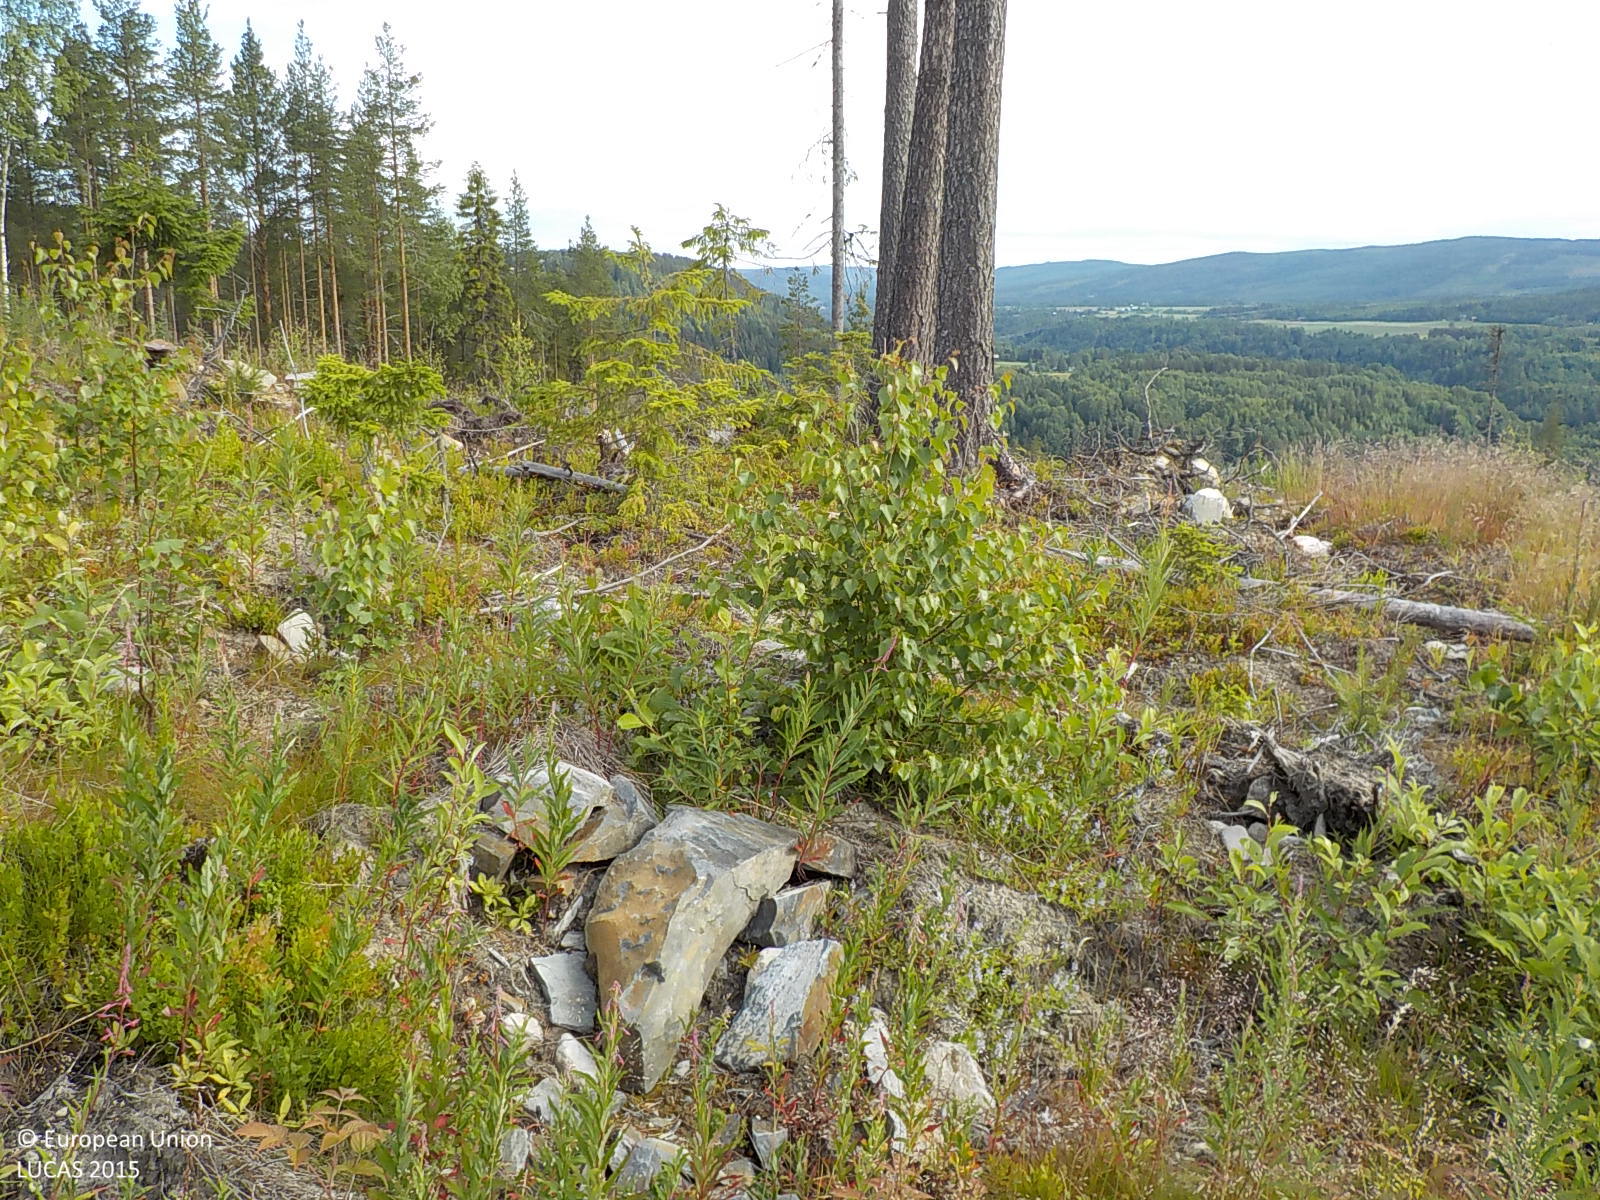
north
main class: Woodland
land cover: Other mixed woodland
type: boreal forest
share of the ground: 25 - 50 %
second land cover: Grassland without tree/shrub cover
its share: 25 - 50 %
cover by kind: herbaceous plants 35 %, coniferous forest trees 30 %, broadleaved forest trees 30 %, shrubs 5 %
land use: Forestry
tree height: < 5 m
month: July
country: SE
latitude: 63.2015
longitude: 17.1923
